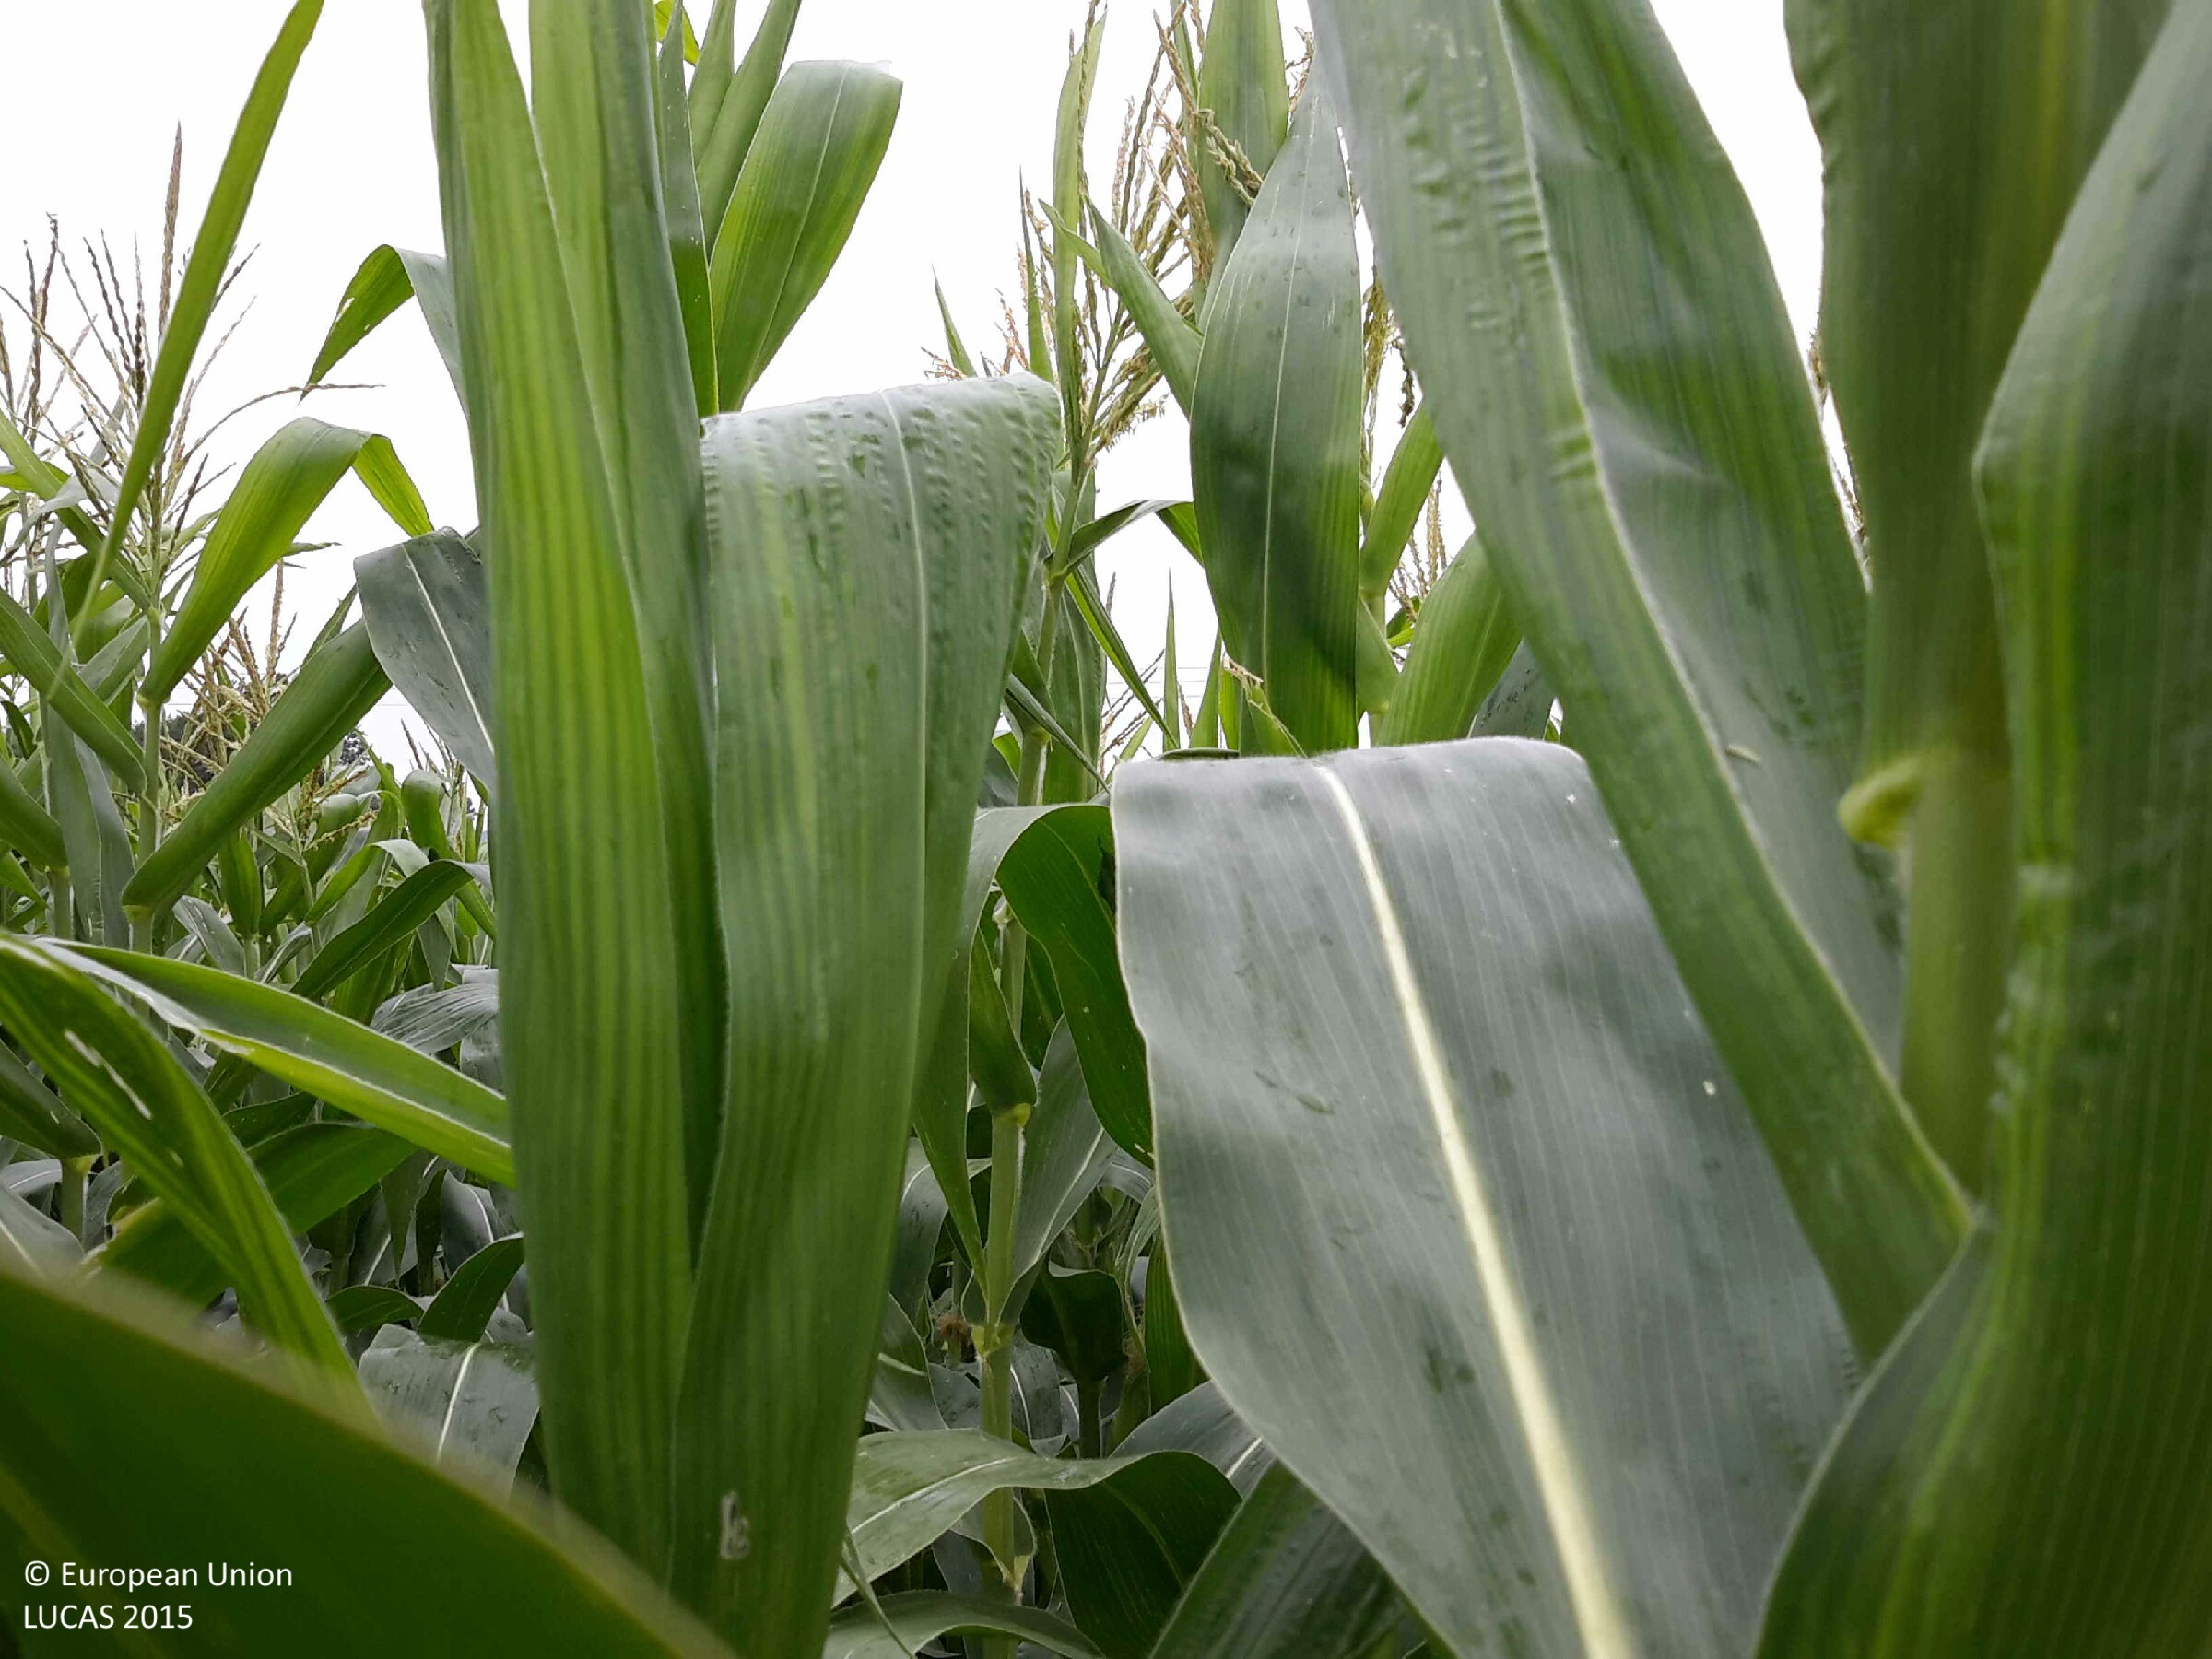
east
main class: Cropland
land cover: Maize
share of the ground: > 75 %
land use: Agriculture (excluding fallow land and kitchen gardens)
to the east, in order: Maize; Electric lines; Maize; Grass margins; Tracks; Grass margins; Sunflower
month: July
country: HU
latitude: 47.4956
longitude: 17.5346
